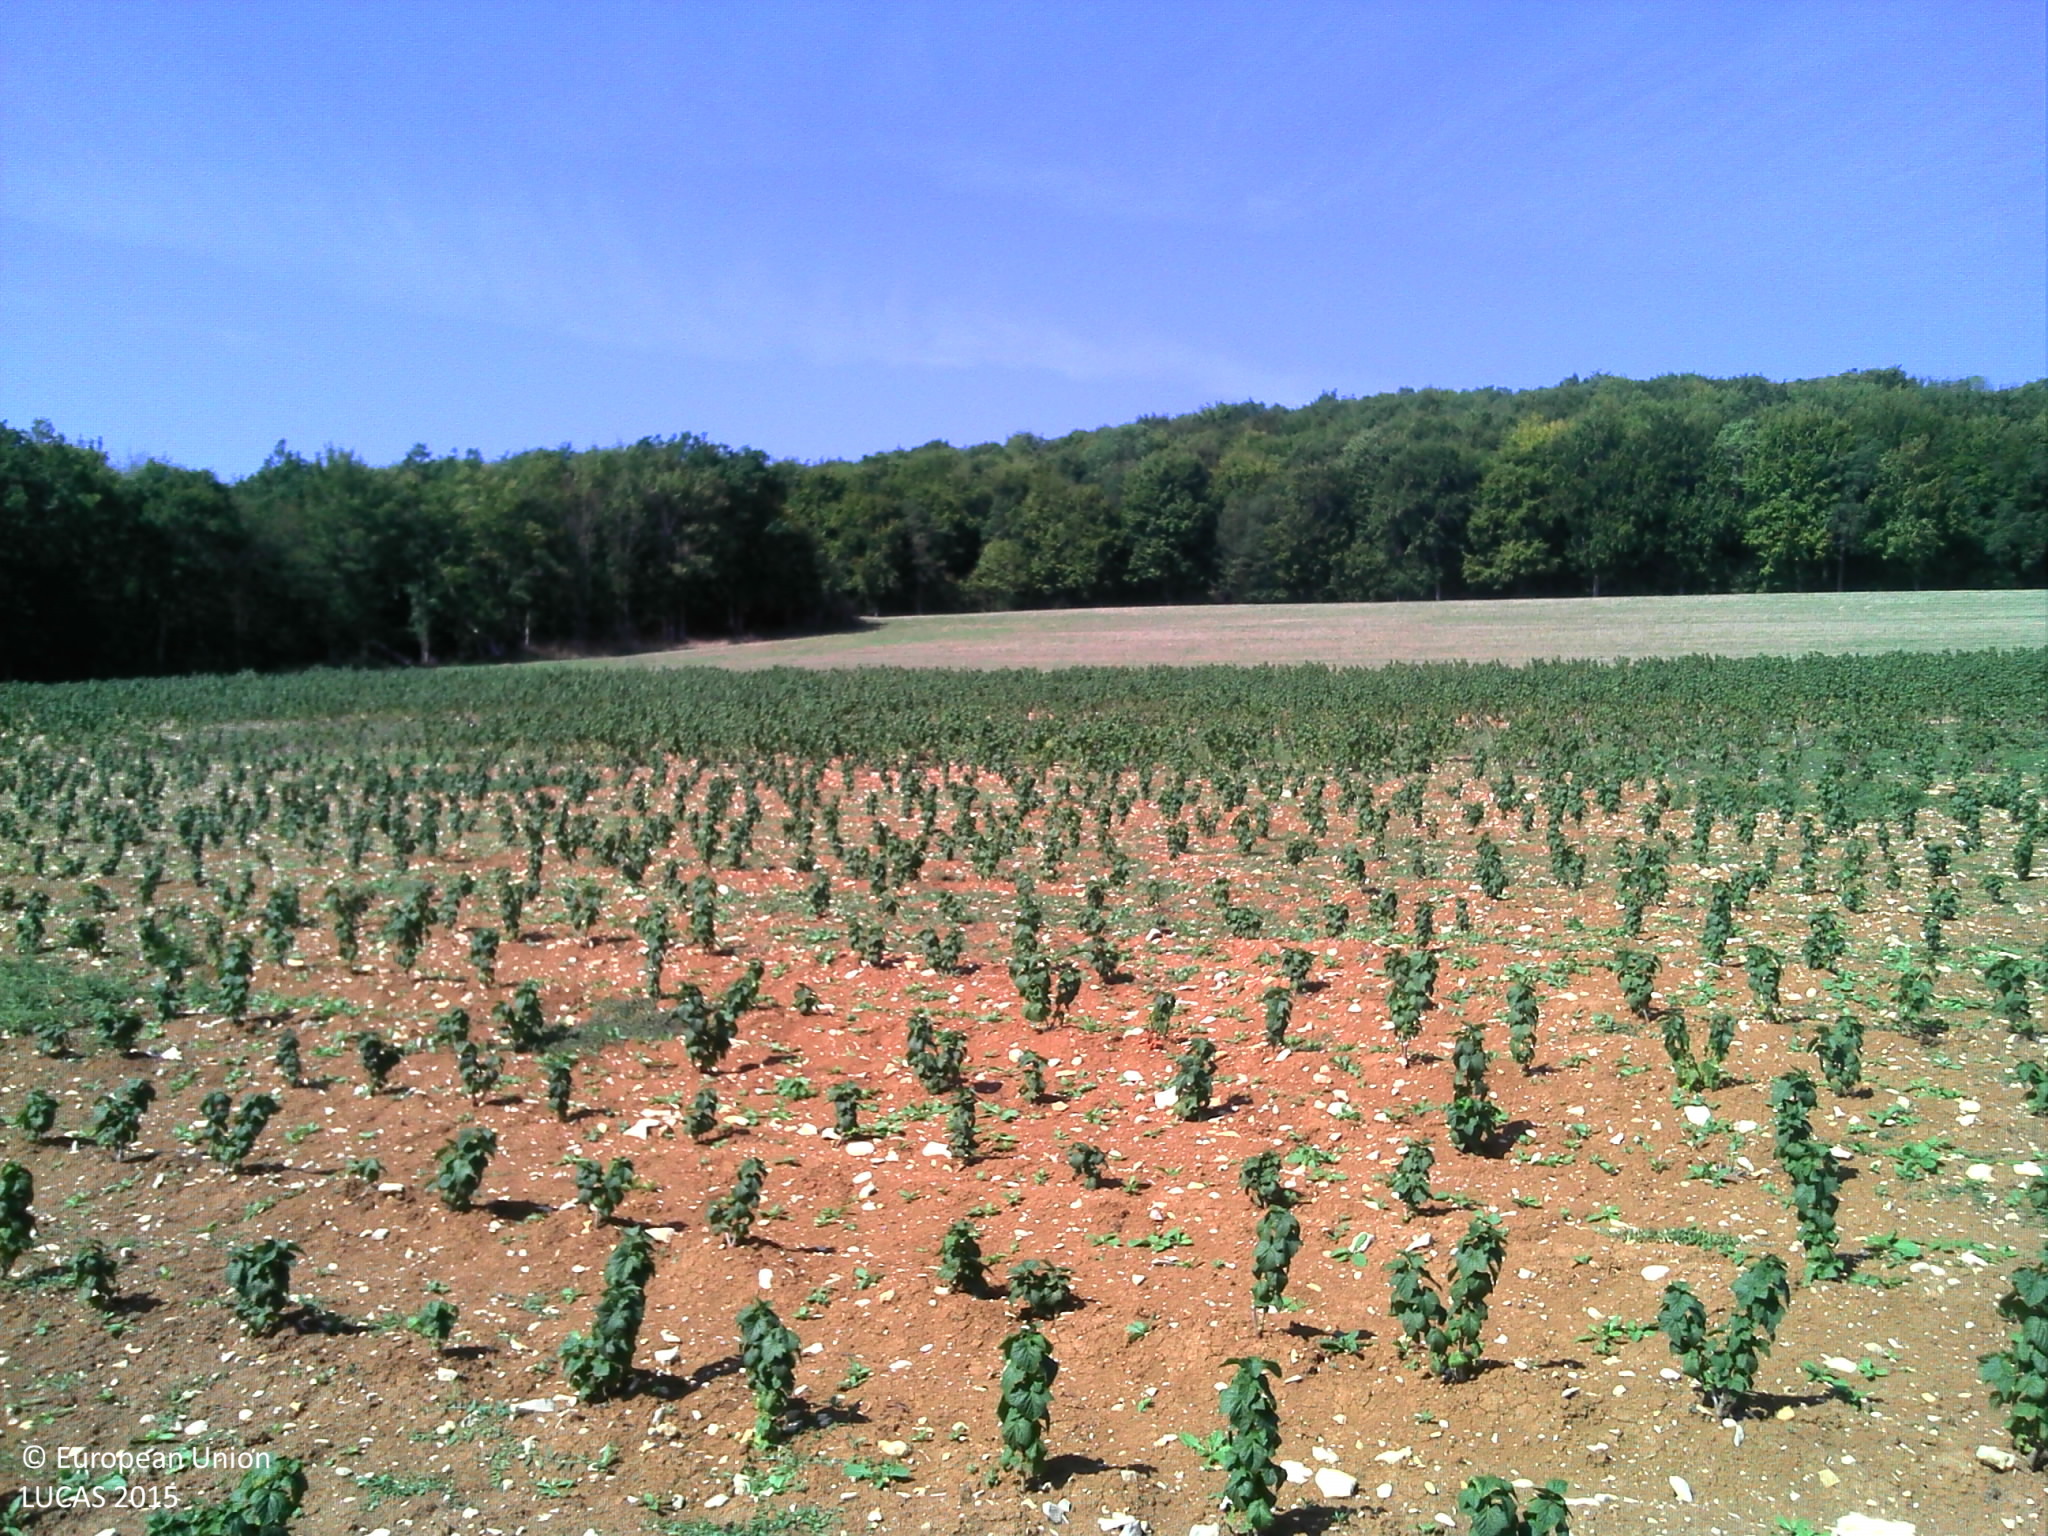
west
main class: Cropland
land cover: Other non-permanent industrial crops
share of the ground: 10 - 25 %
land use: Agriculture (excluding fallow land and kitchen gardens)
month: August
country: FR
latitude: 47.2536
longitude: 4.8073
